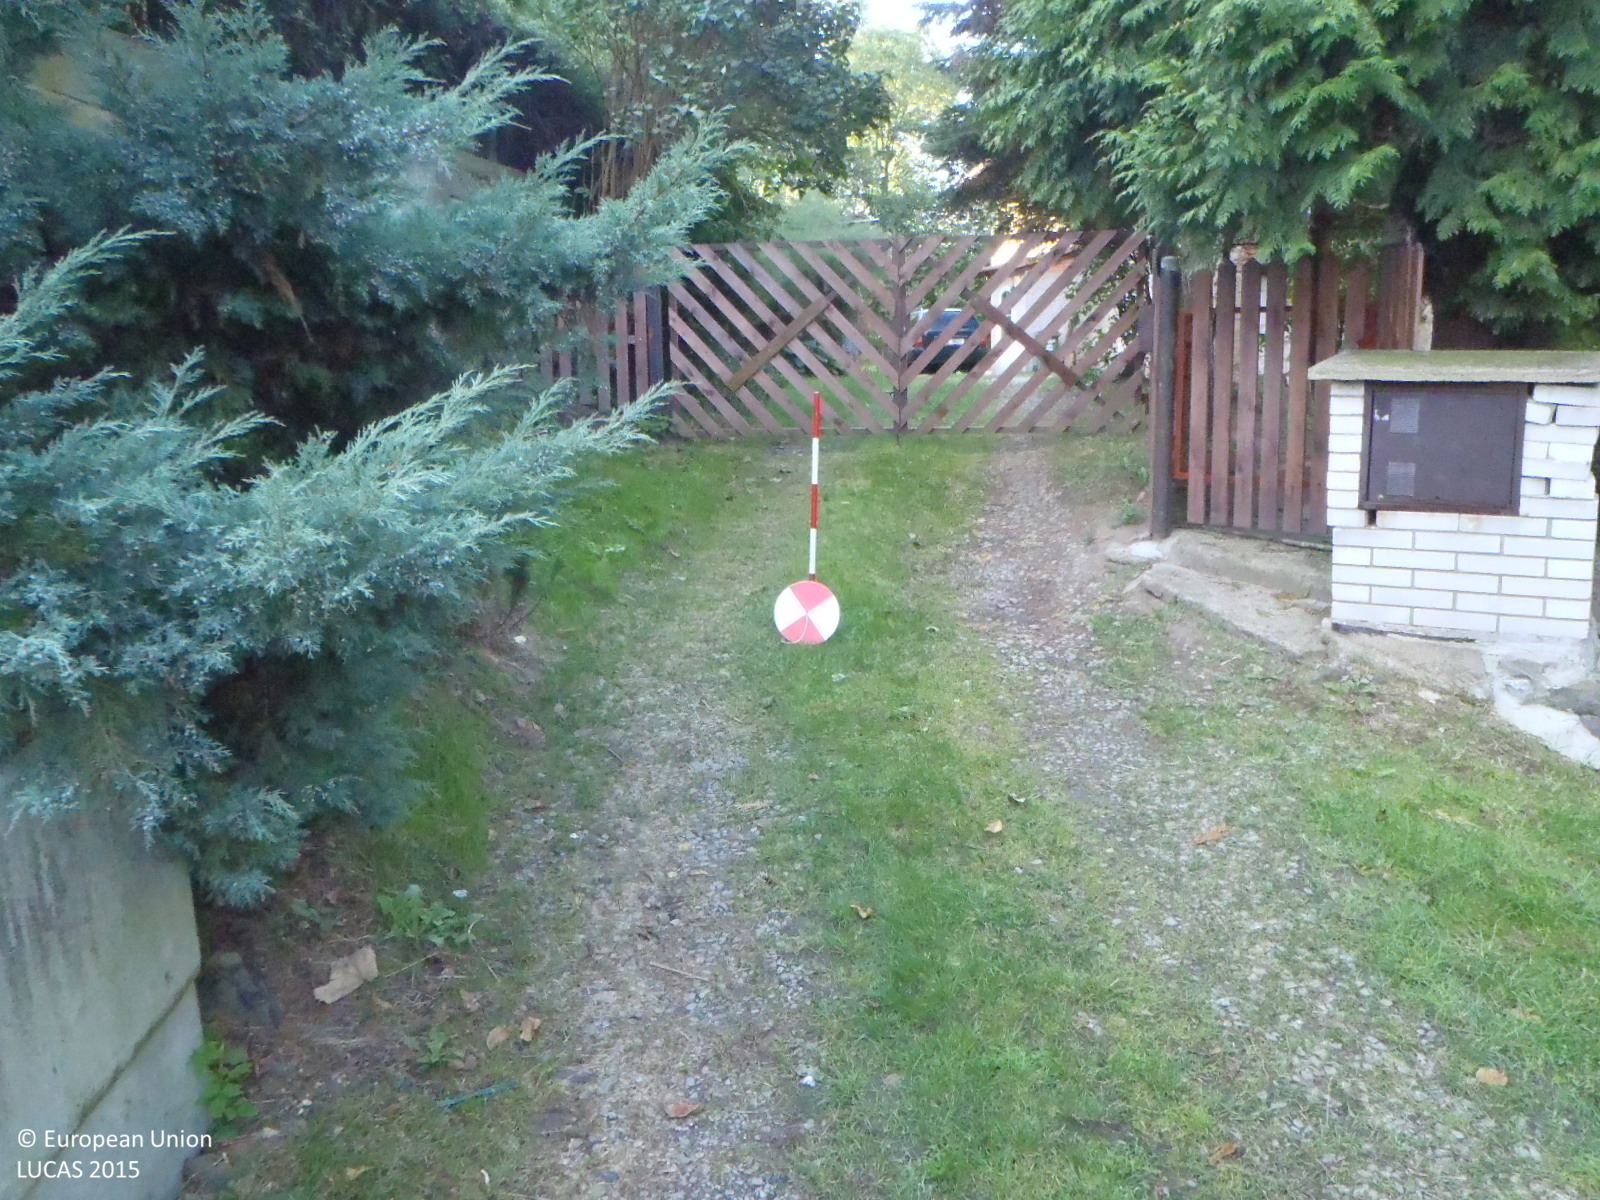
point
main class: Grassland
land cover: Grassland with sparse tree/shrub cover
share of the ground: > 75 %
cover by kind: herbaceous plants 95 %, broadleaved forest trees 5 %
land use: Residential
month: September
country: CZ
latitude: 50.6870
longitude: 14.0918
